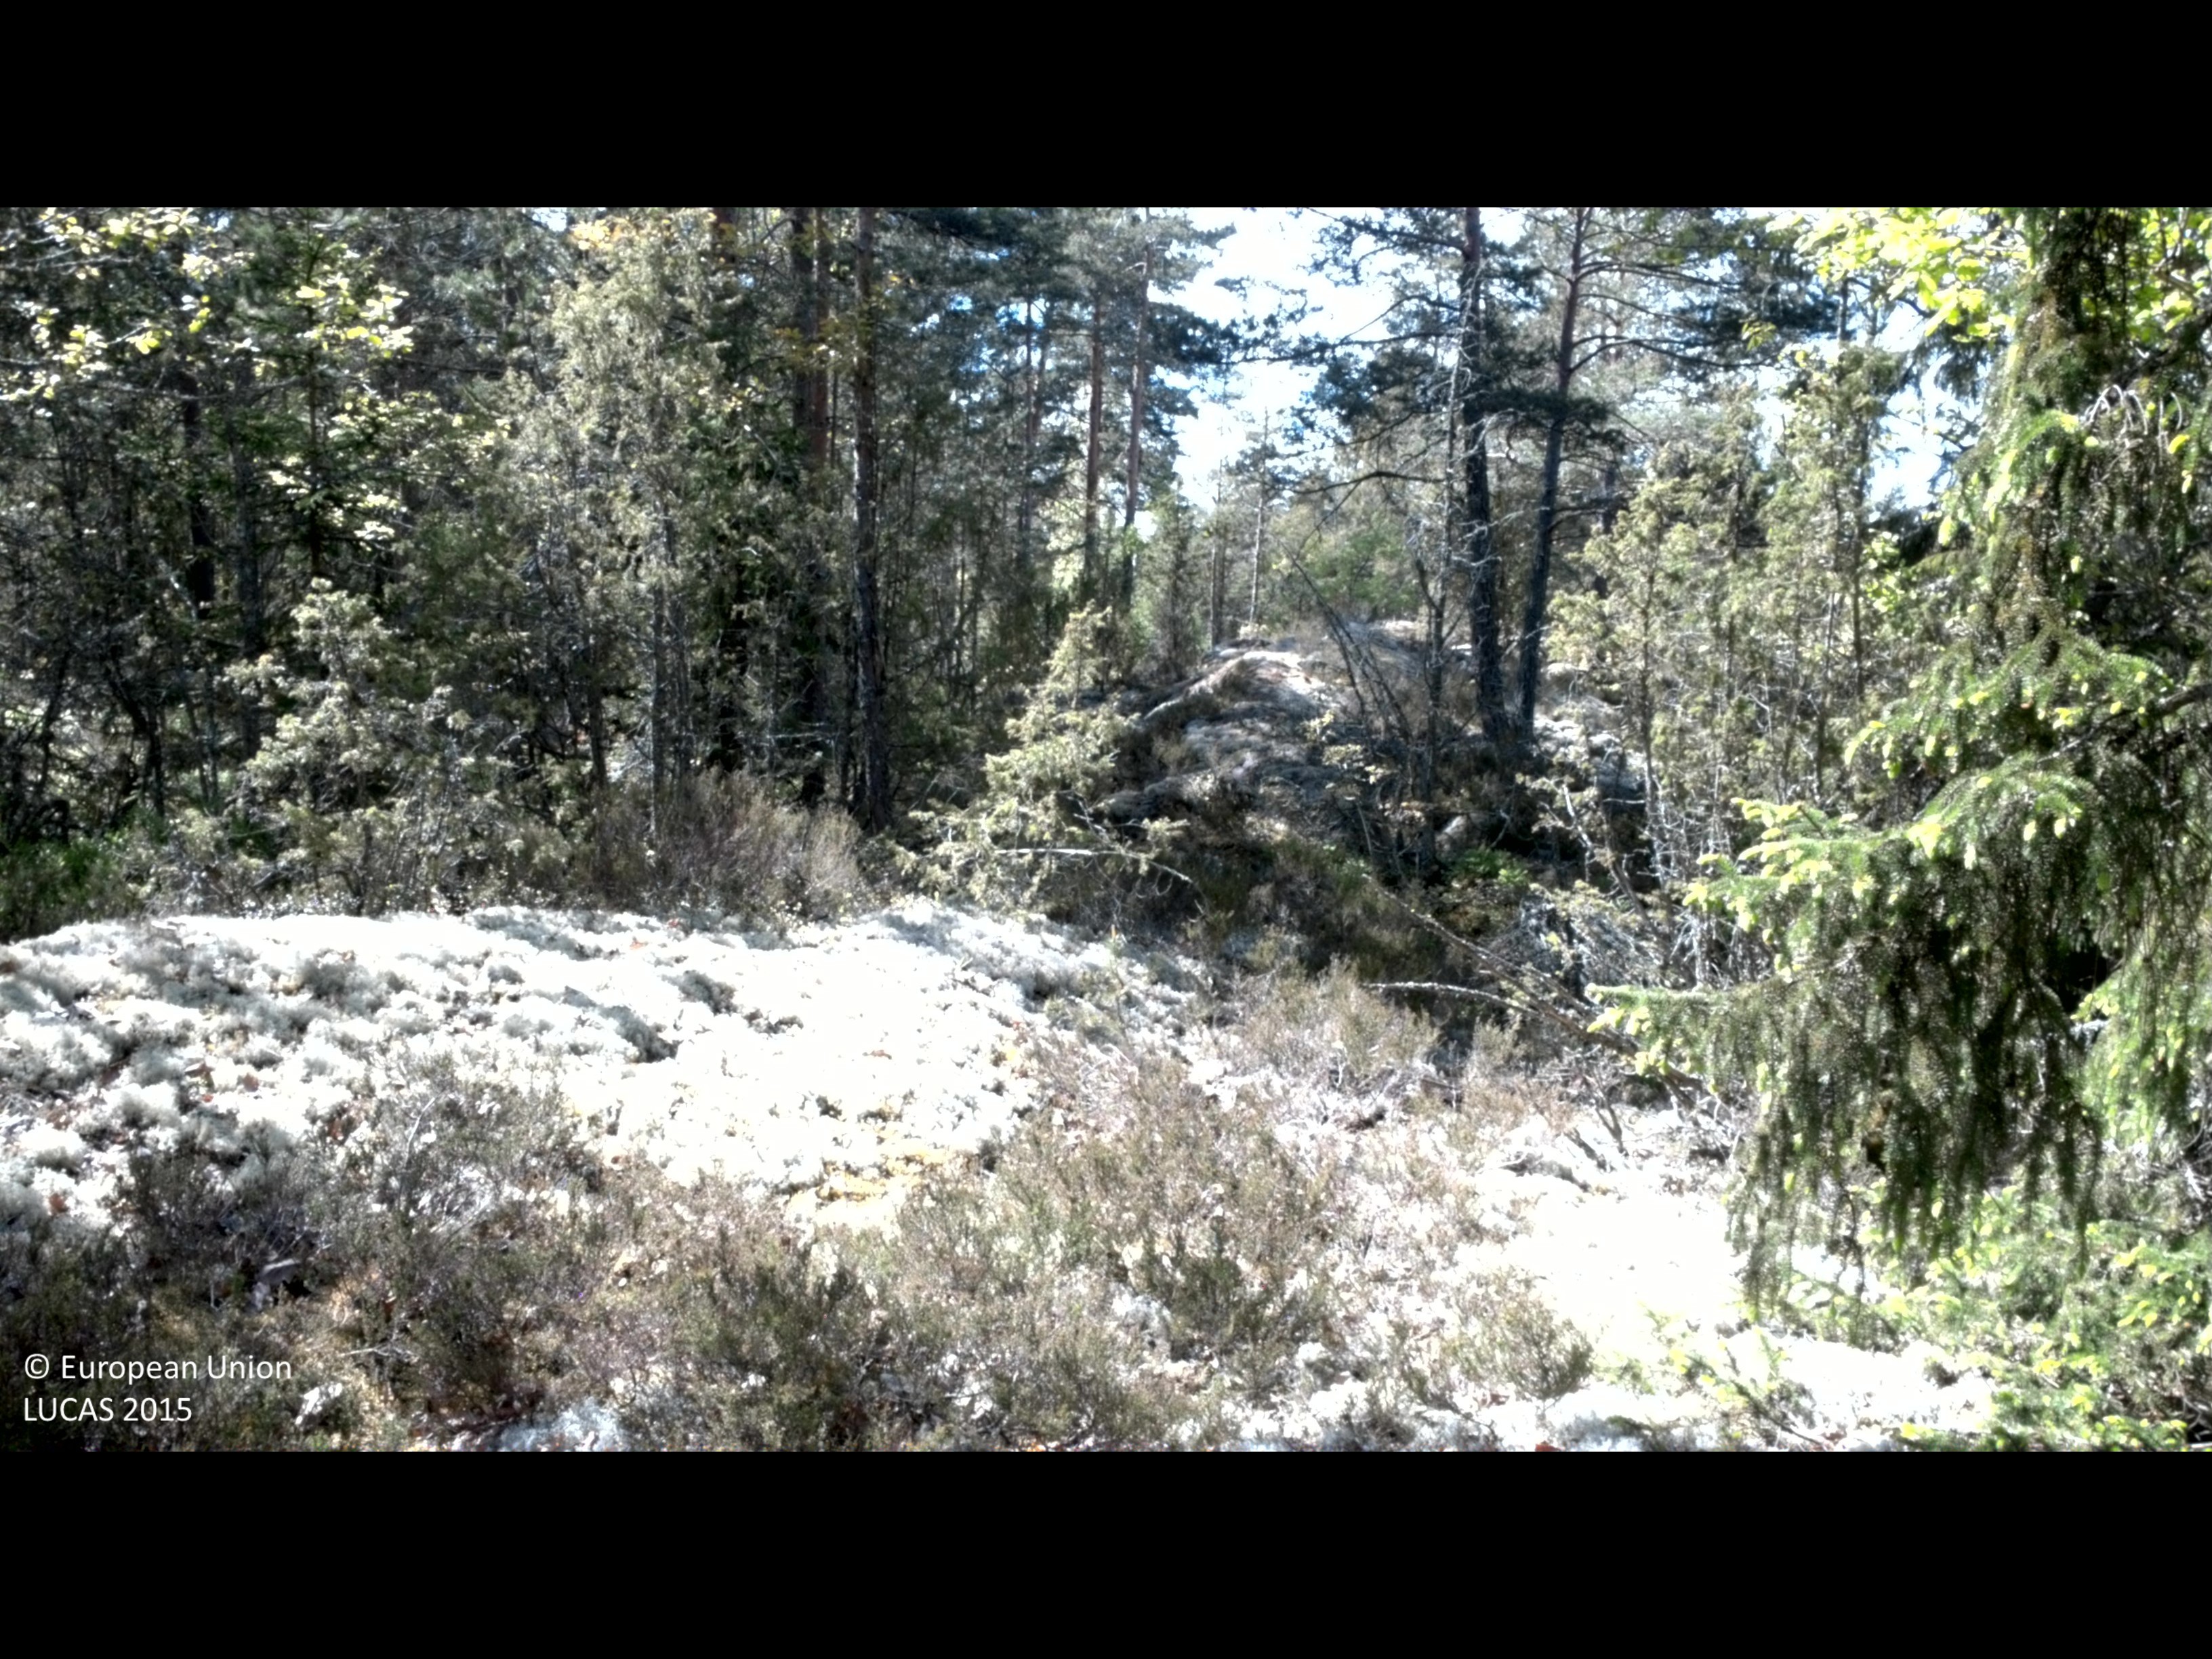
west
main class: Woodland
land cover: Pine dominated coniferous woodland
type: boreal forest
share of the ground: > 75 %
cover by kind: coniferous forest trees 80 %, shrubs 10 %, broadleaved forest trees 5 %, lichens and mosses 5 %
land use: Forestry
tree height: > 5 m
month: May
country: SE
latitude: 57.3026
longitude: 16.1565
